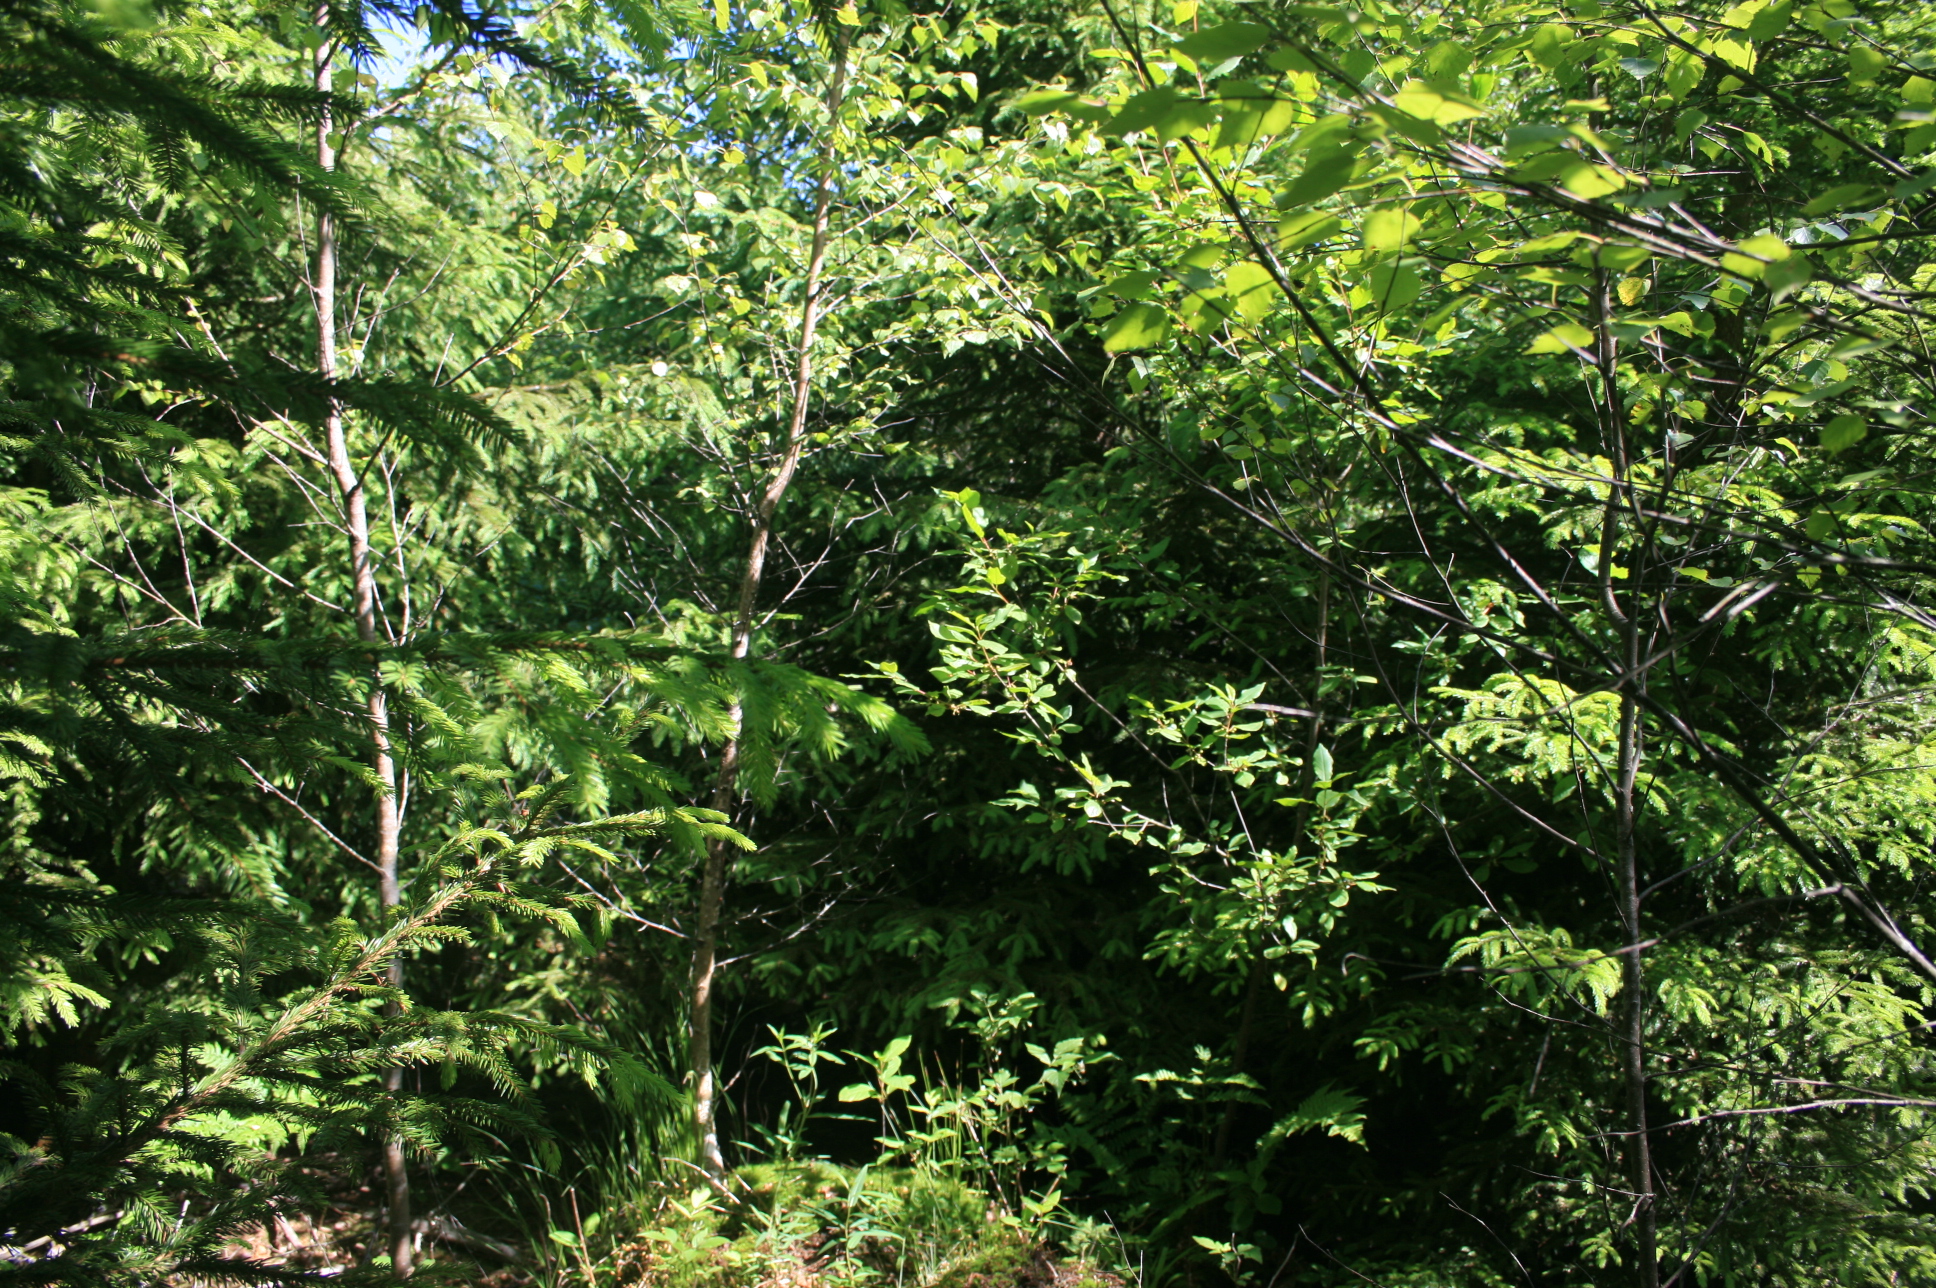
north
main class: Woodland
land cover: Spruce dominated coniferous woodland
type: hemiboreal forest and nemoral coniferous forest and mixed broadleaved-coniferous forest
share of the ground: > 75 %
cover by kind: coniferous forest trees 80 %, broadleaved forest trees 20 %
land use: Forestry
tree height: < 5 m
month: June
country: LT
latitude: 55.4587
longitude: 22.1855
